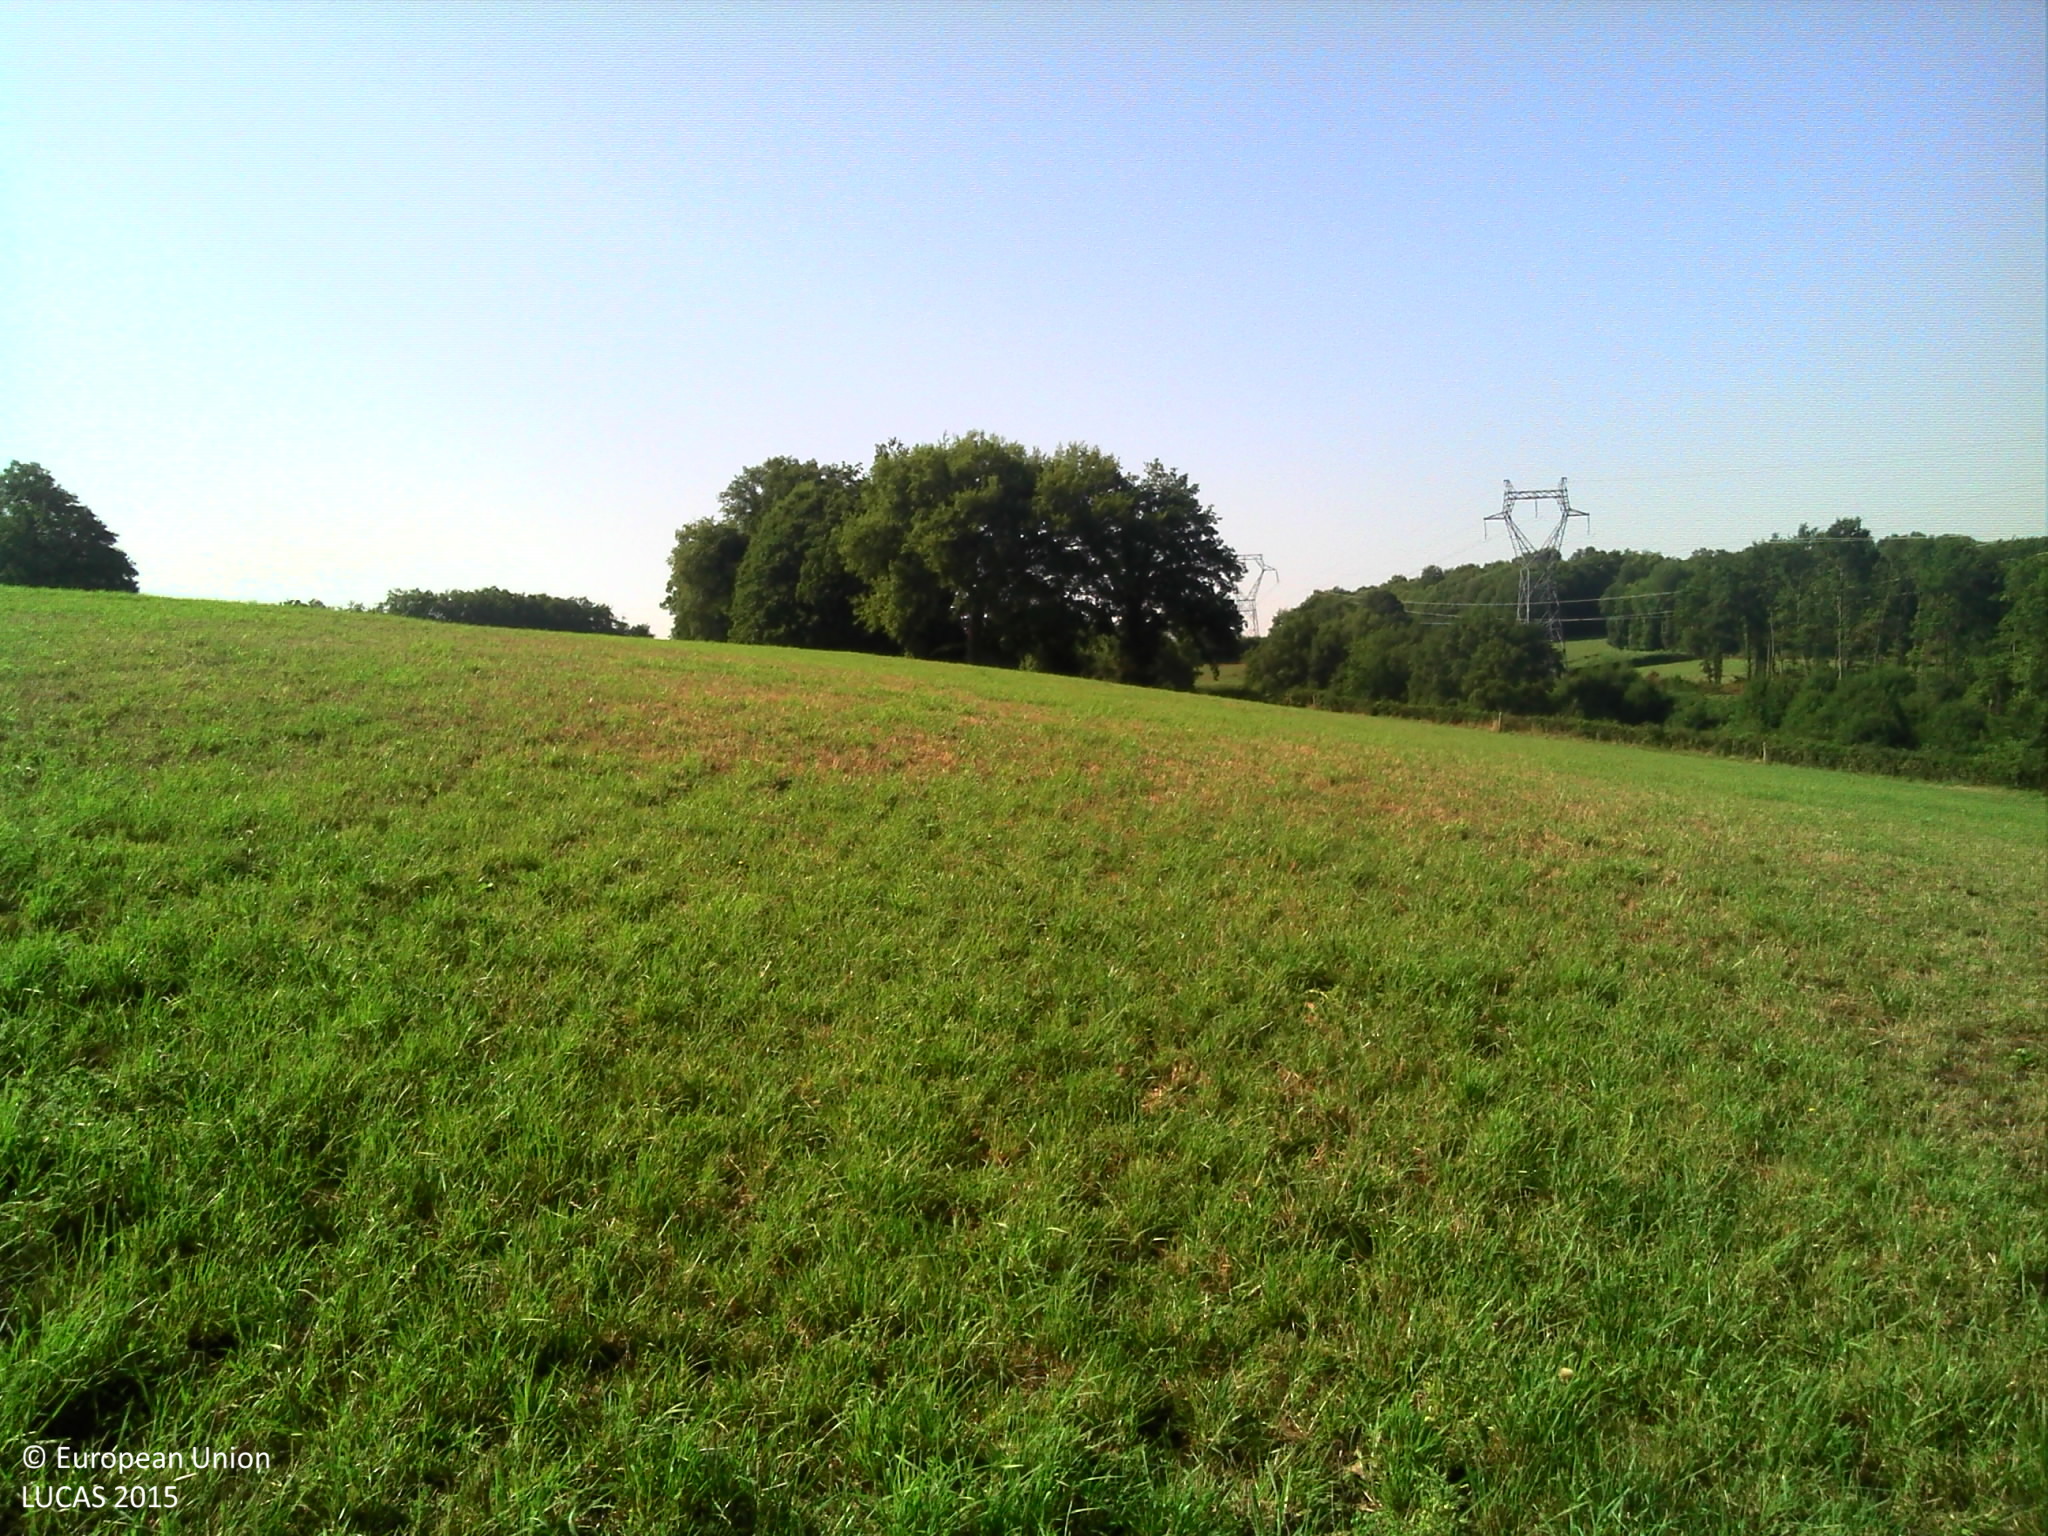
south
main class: Cropland
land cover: Temporary grasslands
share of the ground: > 75 %
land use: Agriculture (excluding fallow land and kitchen gardens)
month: August
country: FR
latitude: 46.1881
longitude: 1.6609
